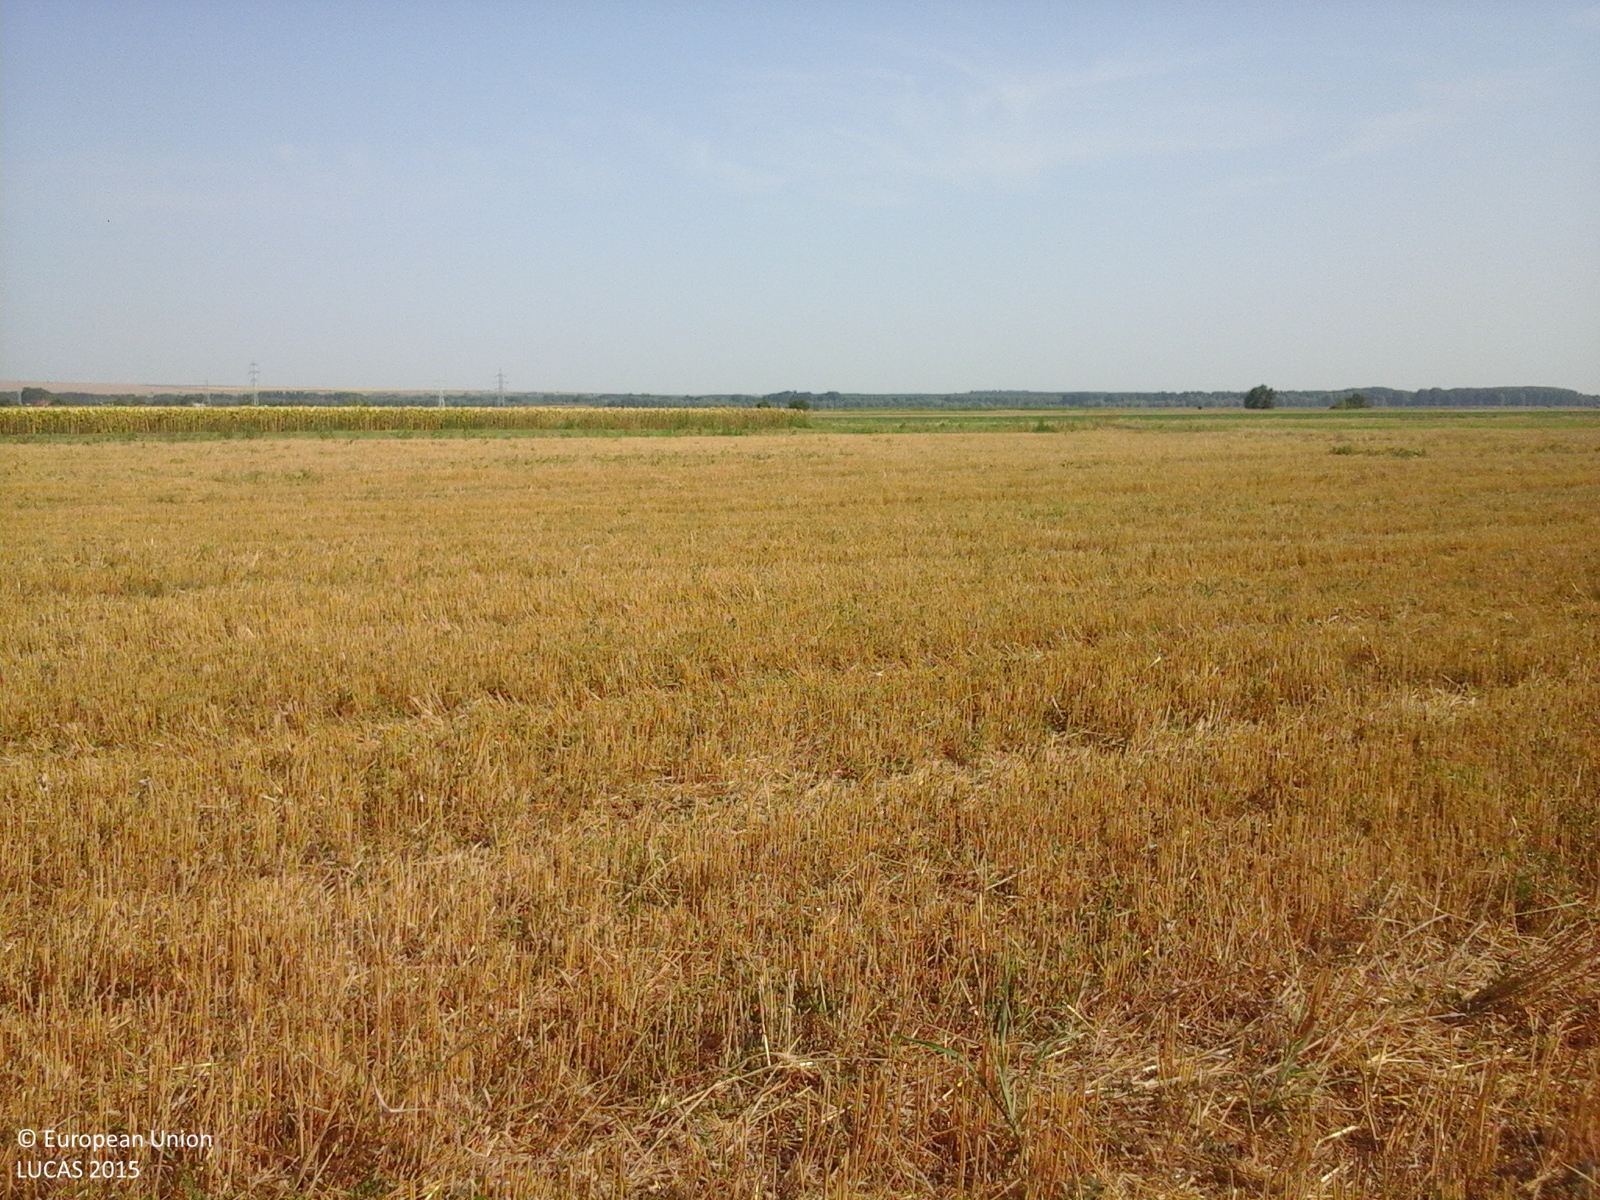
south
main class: Cropland
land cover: Common wheat
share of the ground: 25 - 50 %
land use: Agriculture (excluding fallow land and kitchen gardens)
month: August
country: RO
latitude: 44.8991
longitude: 28.1103
